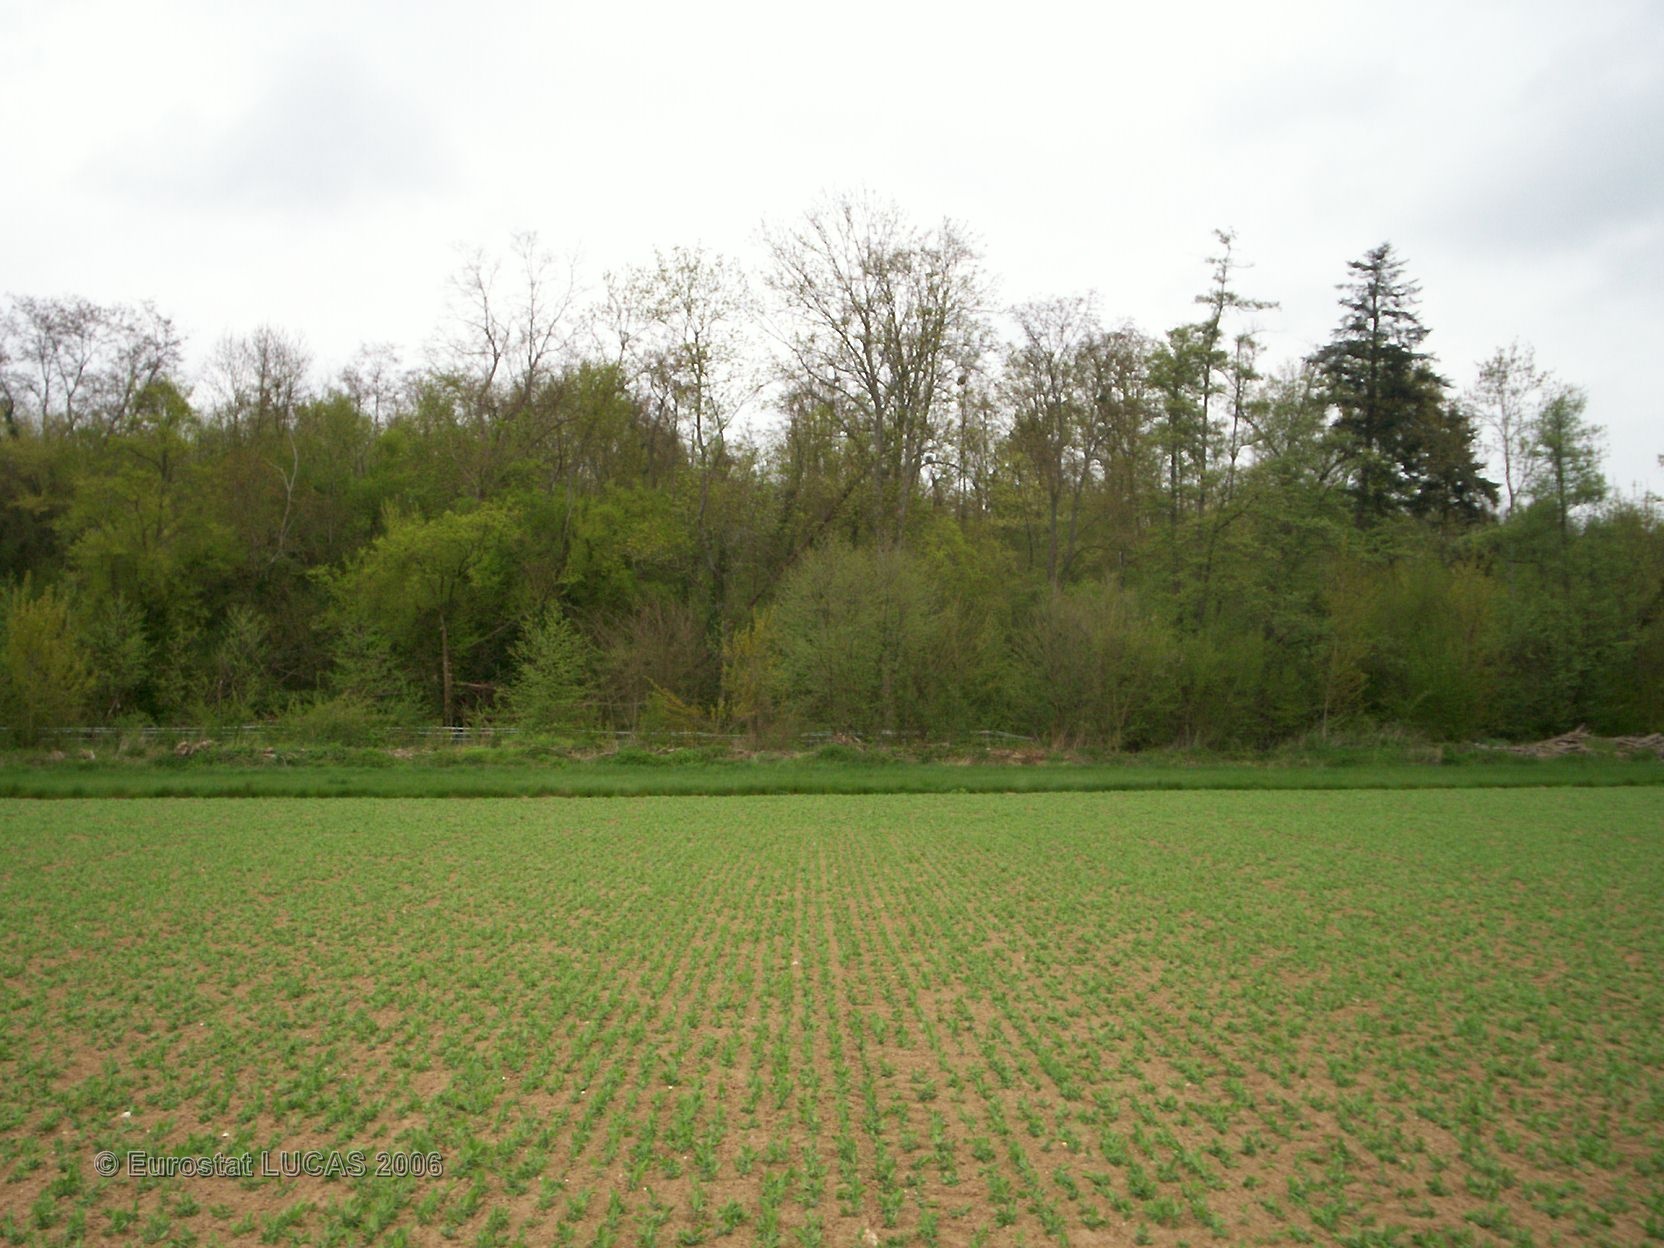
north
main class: Cropland
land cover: Dry pulses
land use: Agriculture (excluding fallow land and kitchen gardens)
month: May
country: FR
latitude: 48.1397
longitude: 2.9099
